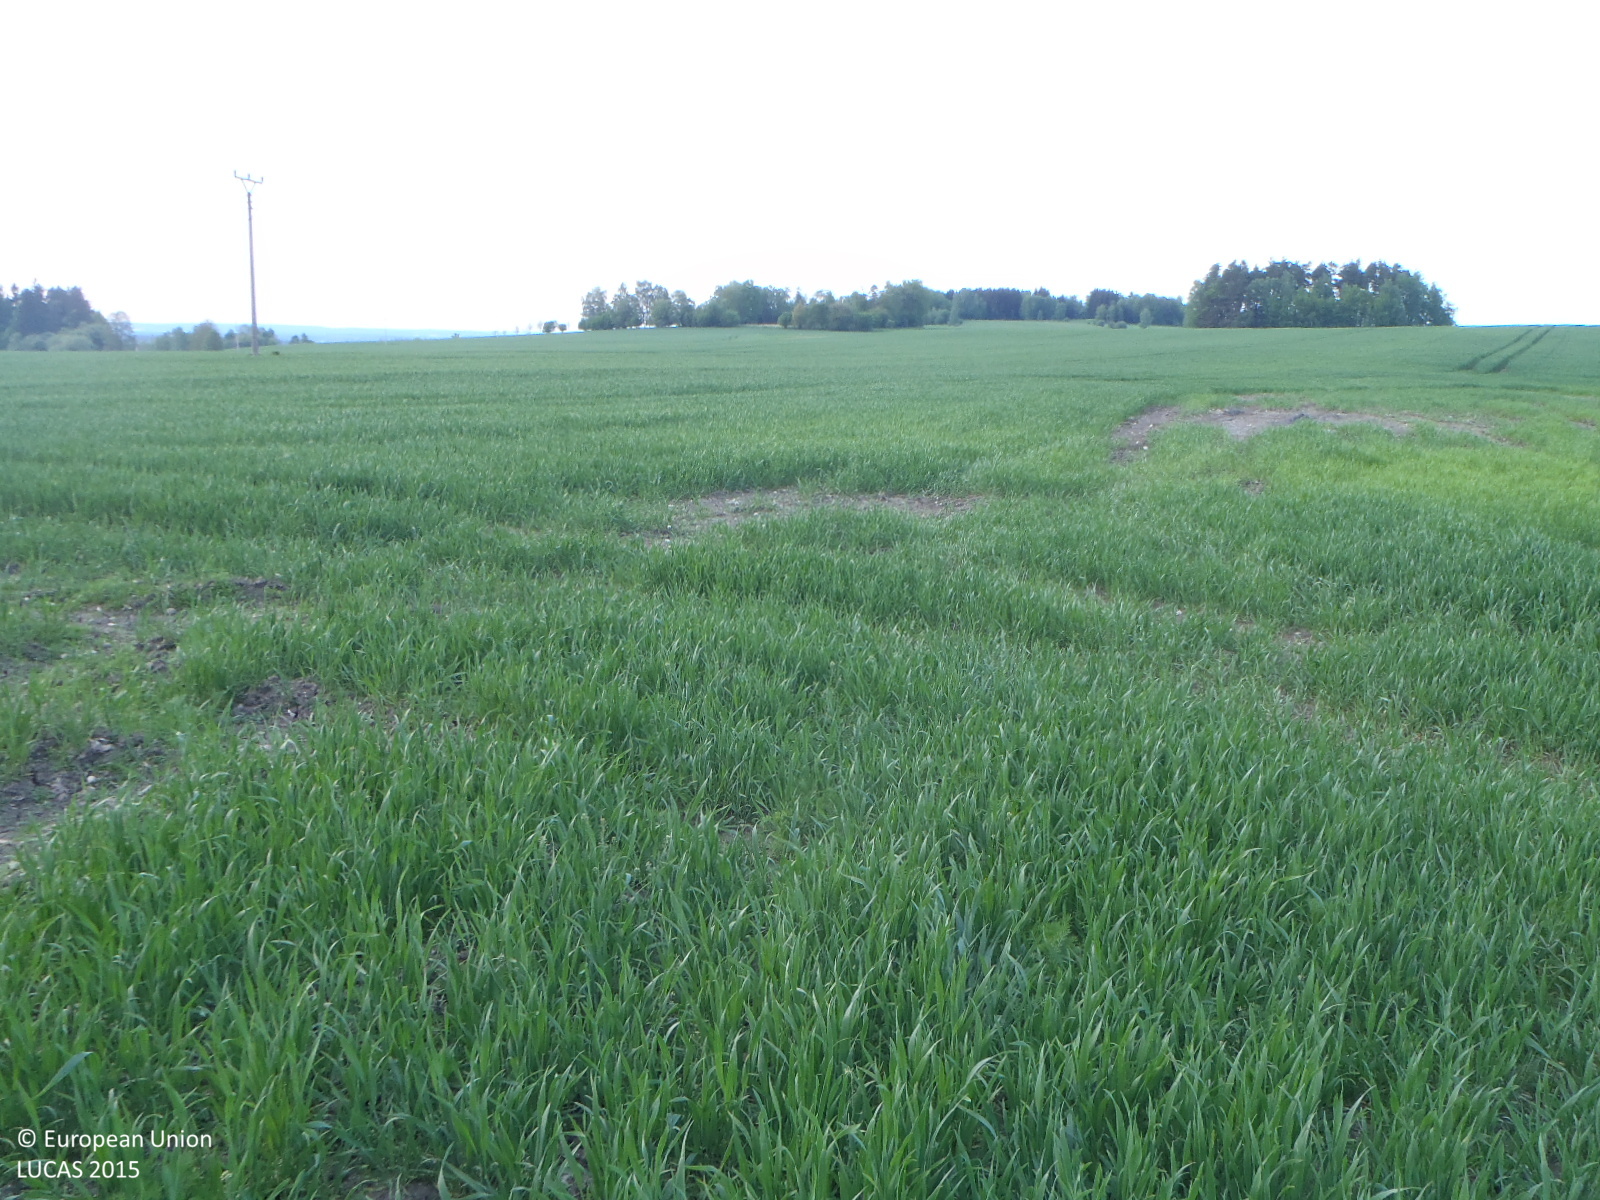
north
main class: Cropland
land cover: Triticale
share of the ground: 50 - 75 %
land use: Agriculture (excluding fallow land and kitchen gardens)
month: May
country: CZ
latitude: 49.1349
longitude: 15.0599
